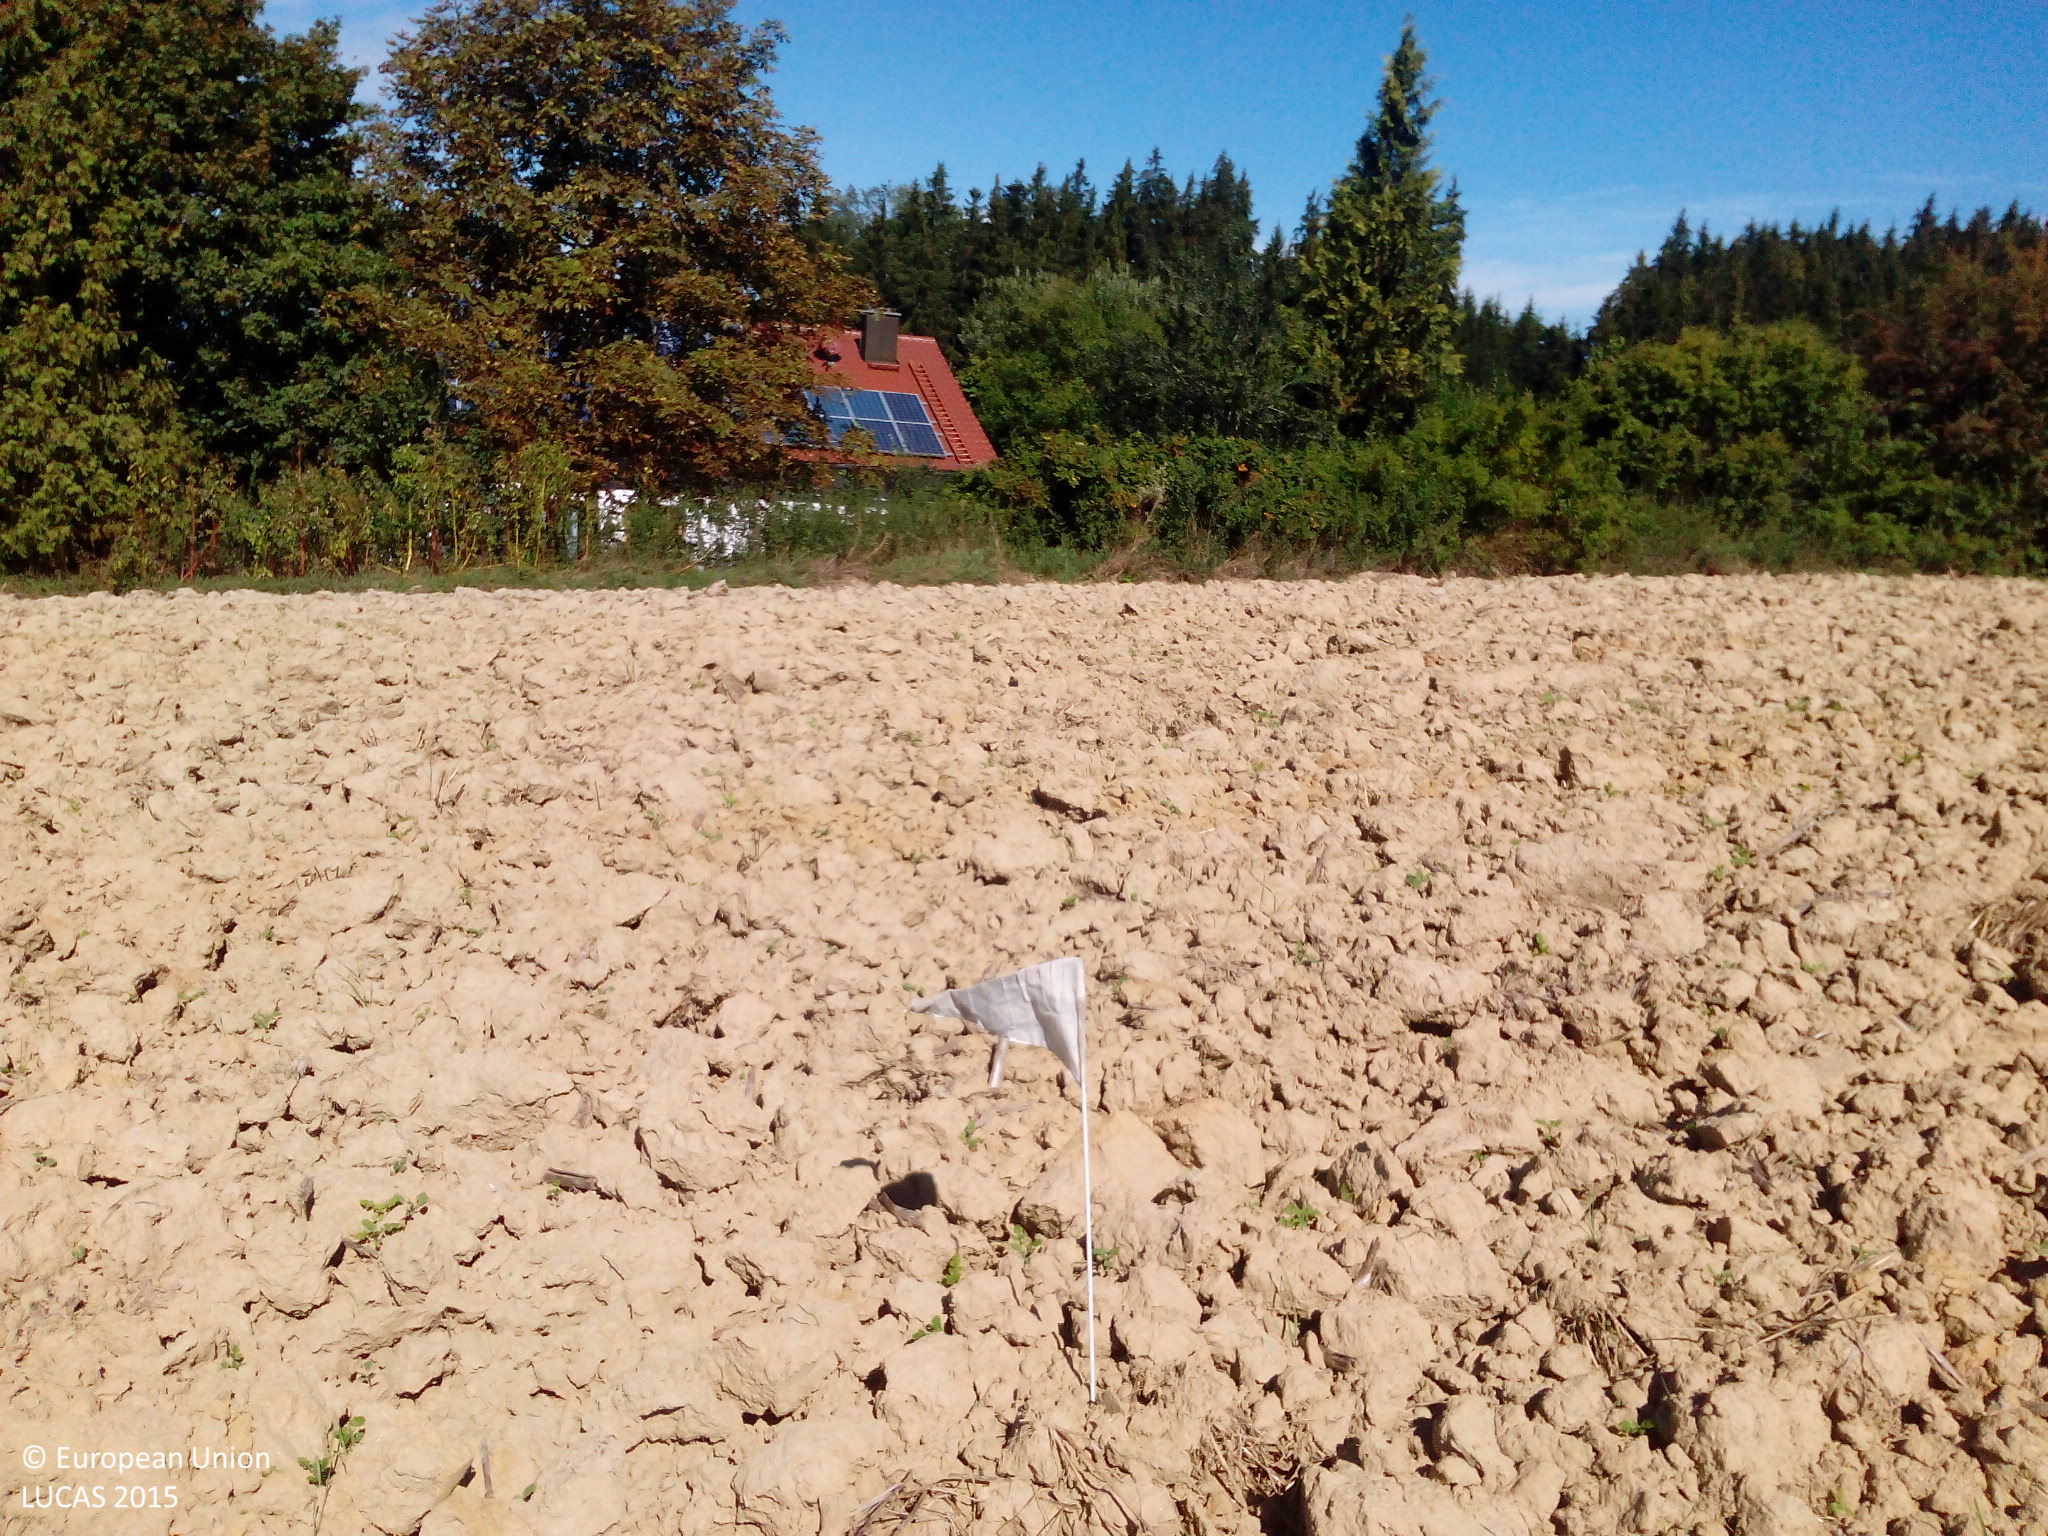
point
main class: Cropland
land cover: Rape and turnip rape
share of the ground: < 10 %
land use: Agriculture (excluding fallow land and kitchen gardens)
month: September
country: DE
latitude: 48.4202
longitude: 12.0665
